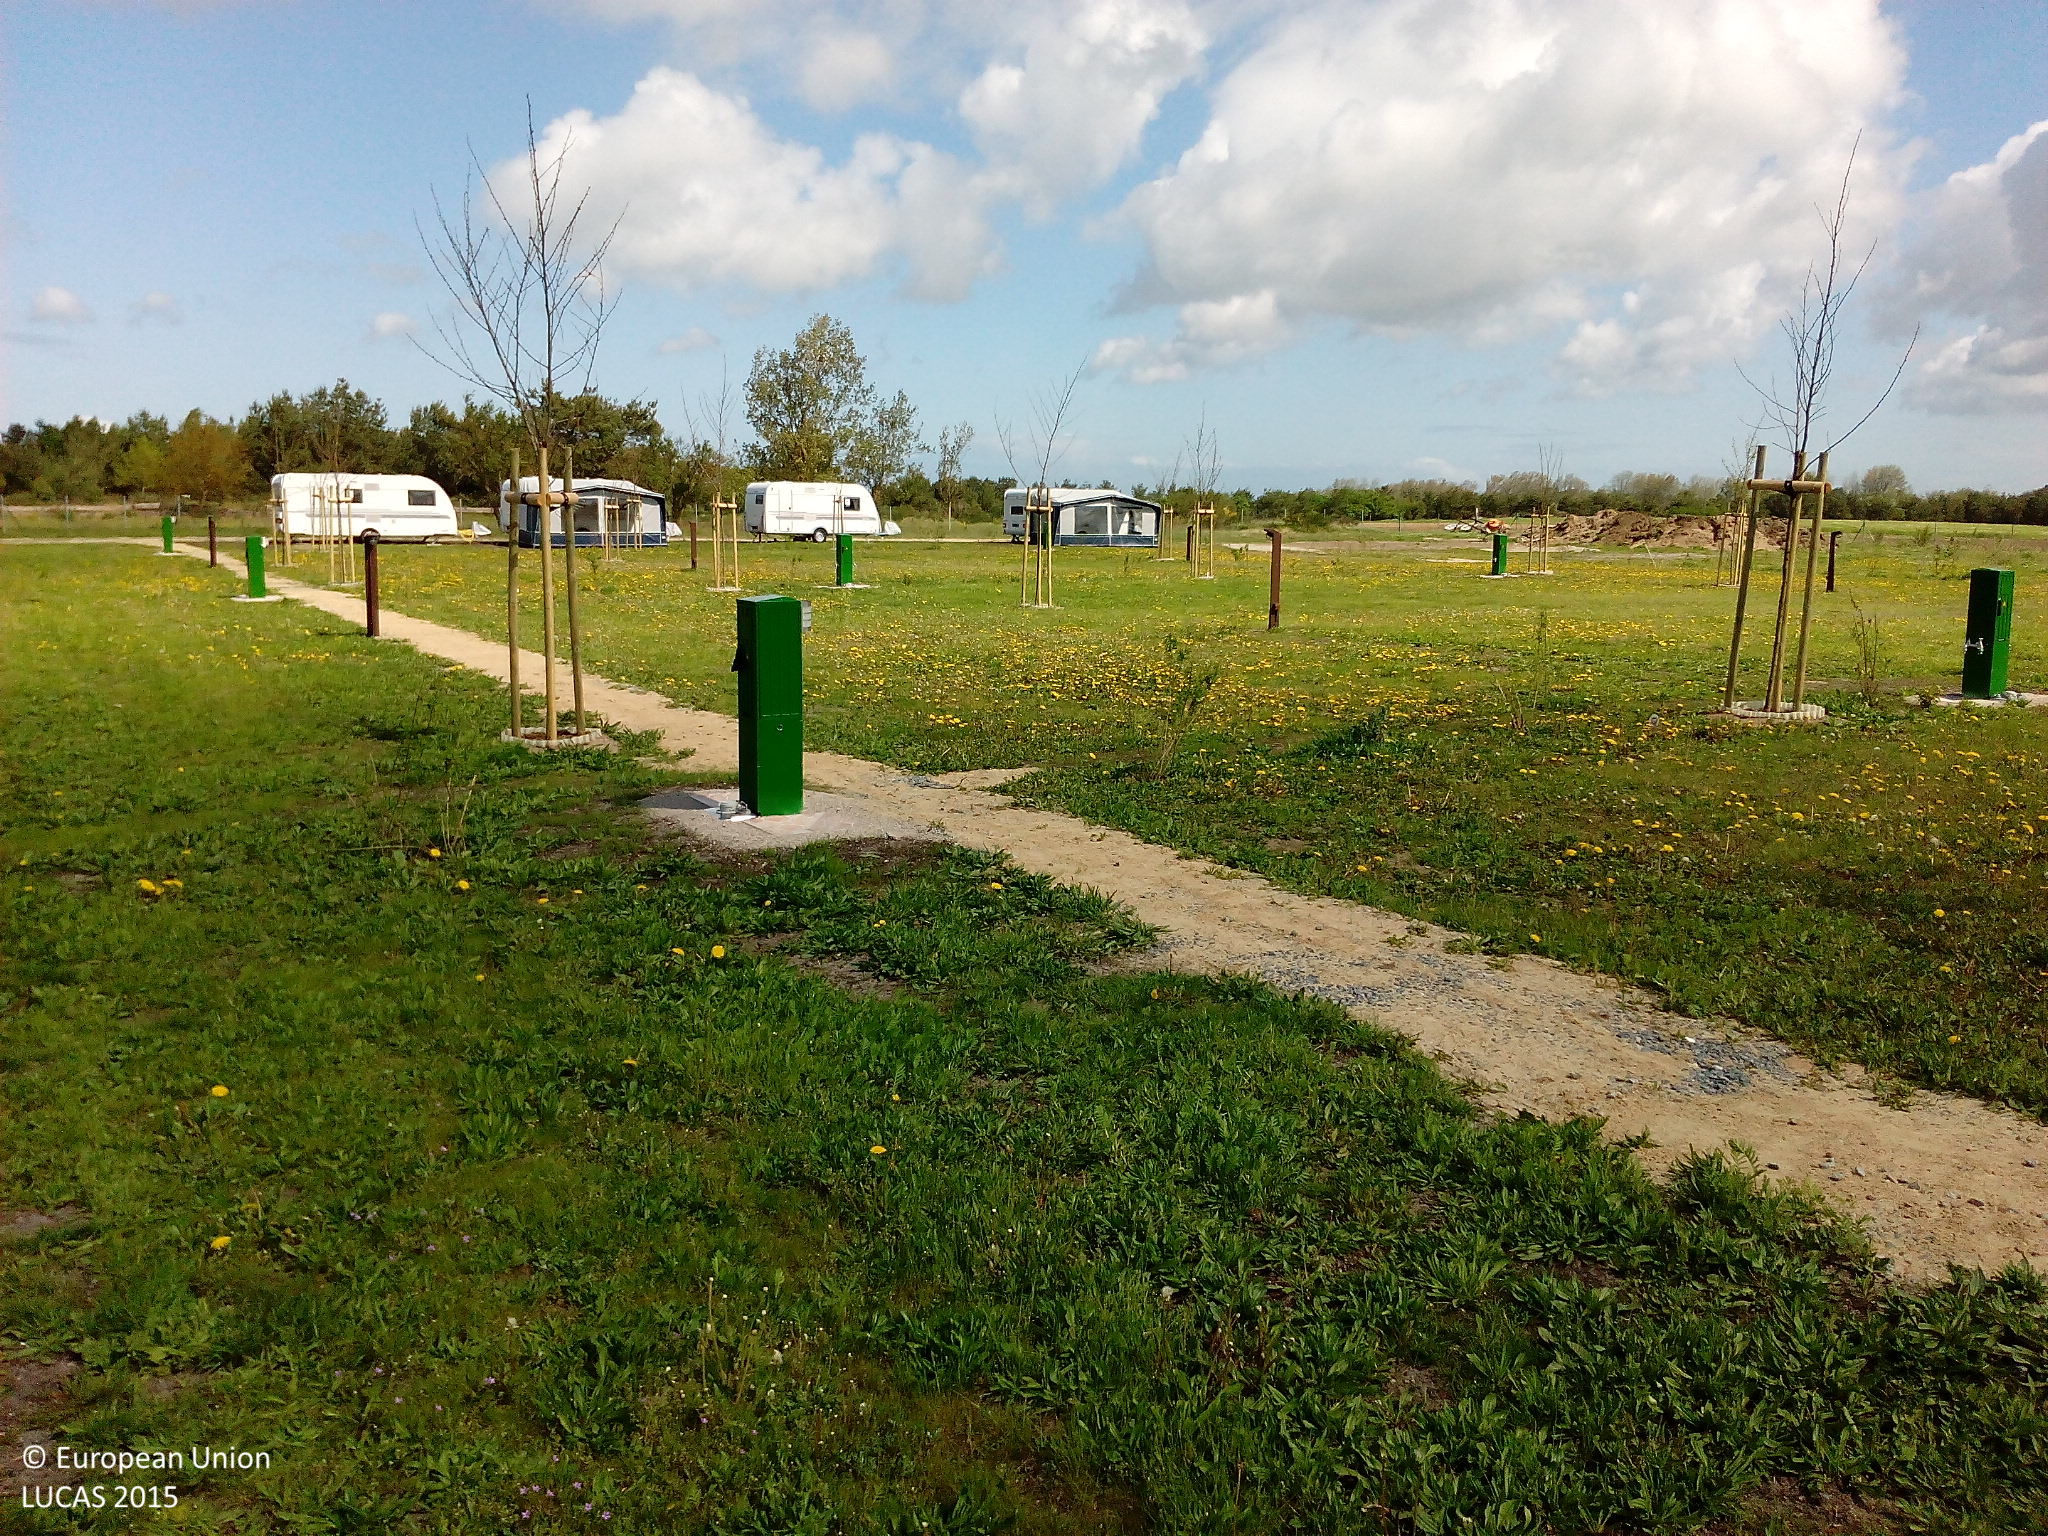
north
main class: Grassland
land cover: Grassland with sparse tree/shrub cover
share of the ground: > 75 %
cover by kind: herbaceous plants 85 %, broadleaved forest trees 5 %, shrubs 5 %, unconsolidated bare surface 5 %
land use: Amenities, museums, leisure
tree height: < 5 m
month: May
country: DE
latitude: 54.3797
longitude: 12.6625
